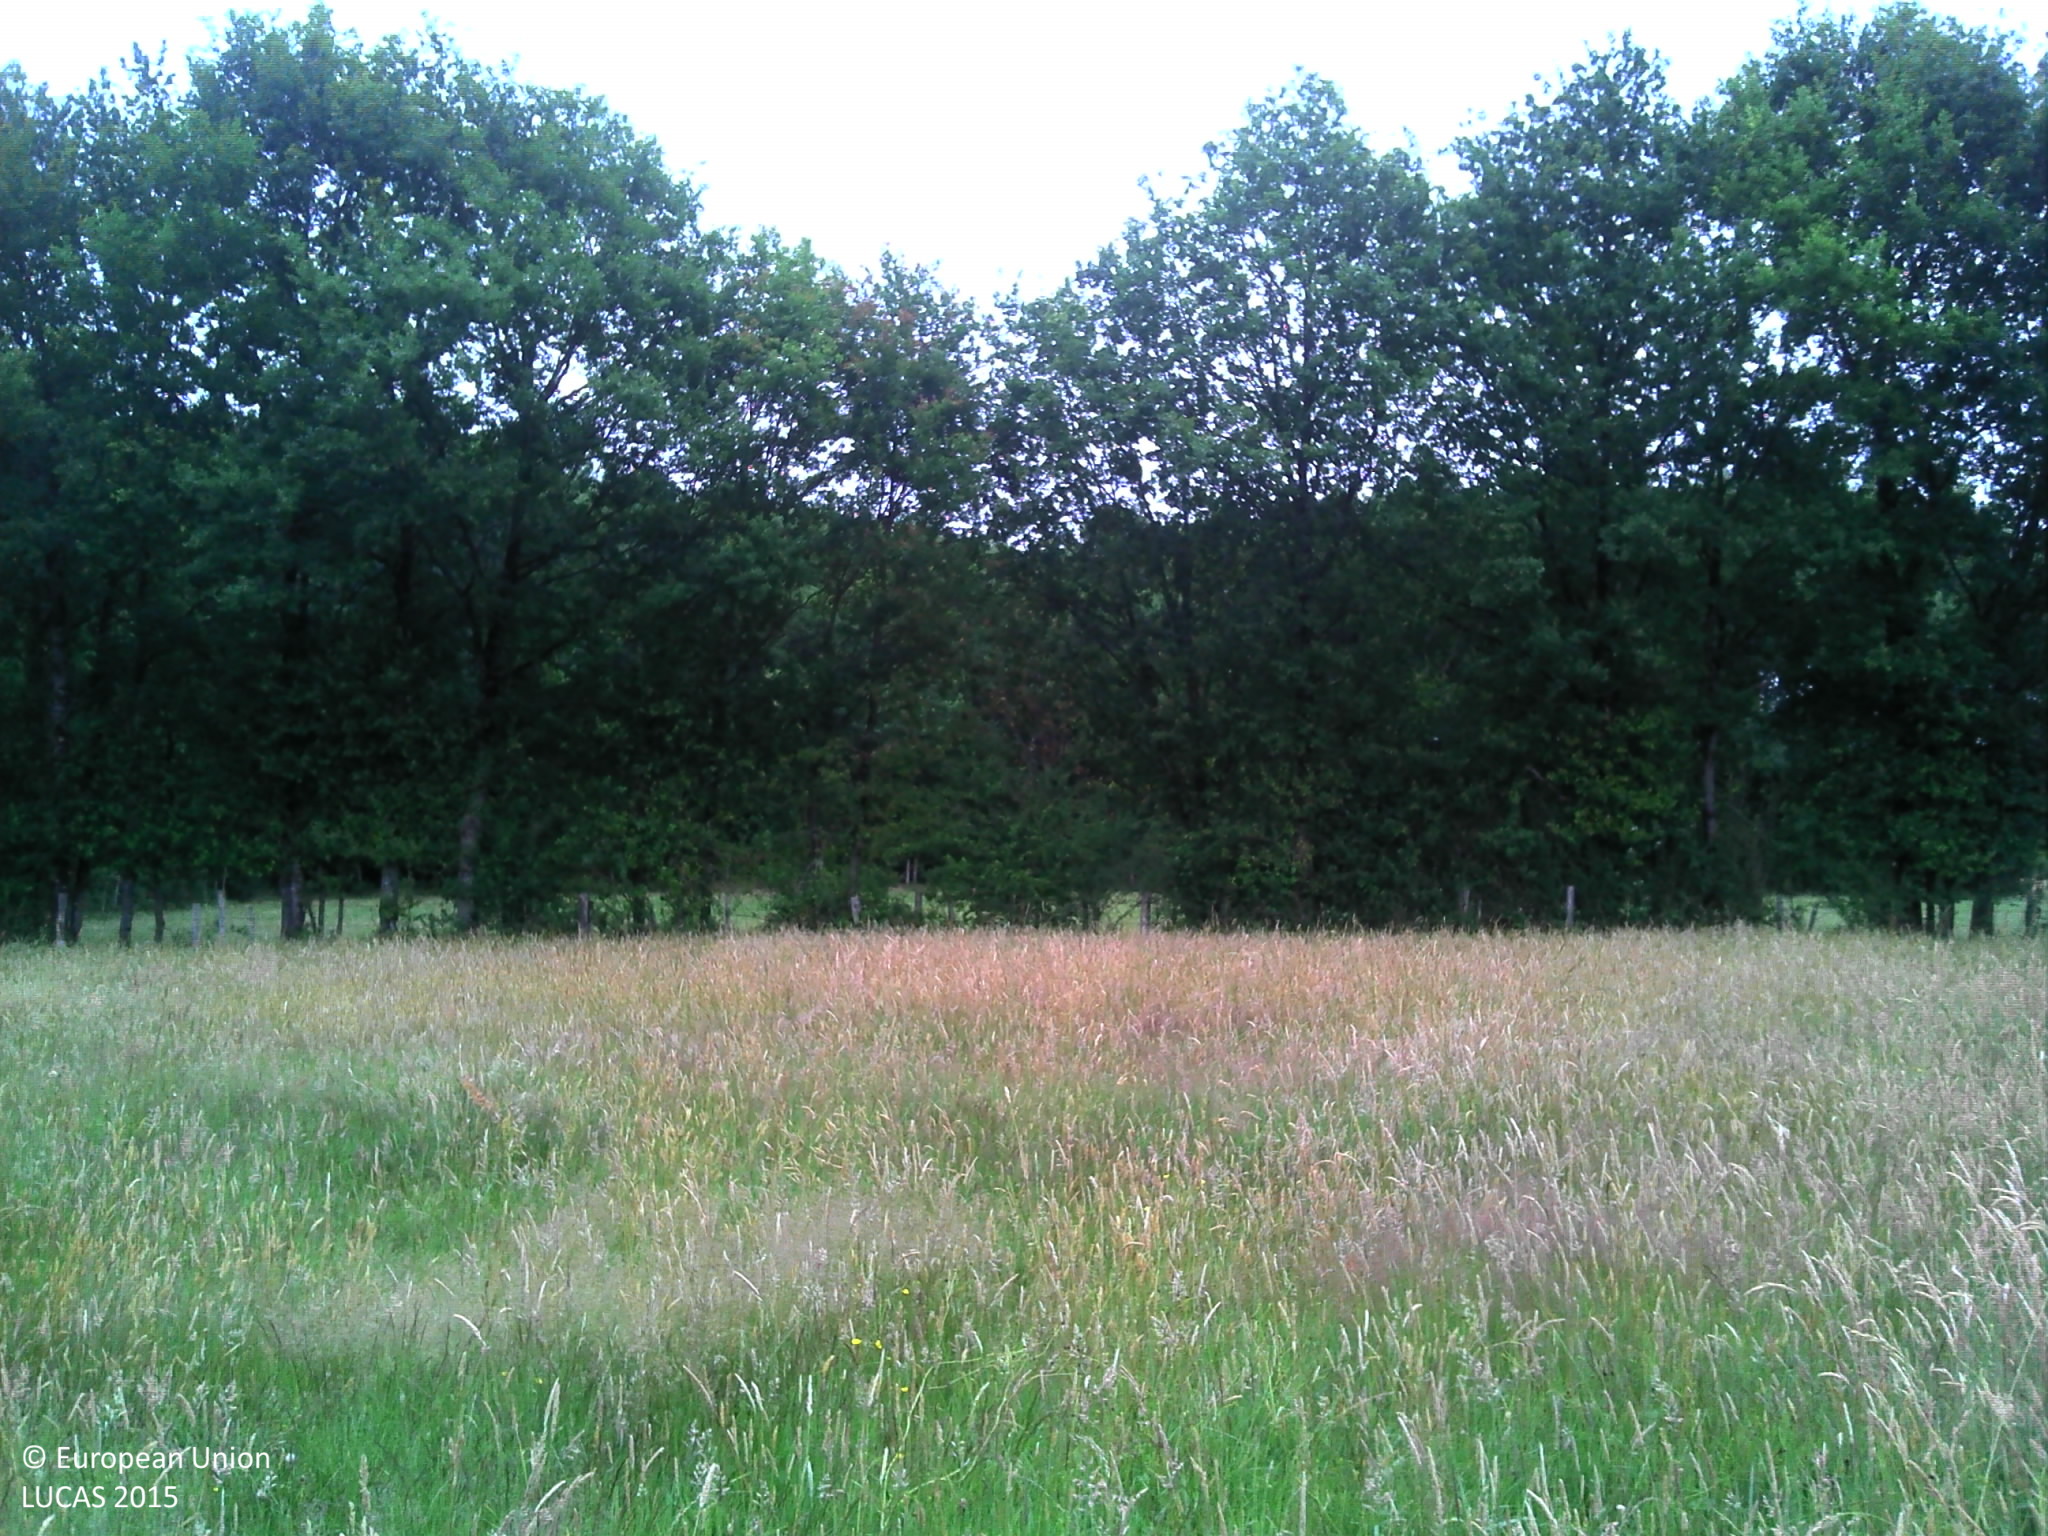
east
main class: Grassland
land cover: Grassland without tree/shrub cover
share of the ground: > 75 %
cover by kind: herbaceous plants 100 %
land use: Agriculture (excluding fallow land and kitchen gardens)
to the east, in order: Grassland without tree/shrub cover; Fences; Abandoned hedges; Grassland without tree/shrub cover; Fences; Broadleaved woodland; Fences; Grassland without tree/shrub cover
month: June
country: FR
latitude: 47.6460
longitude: 0.0565
